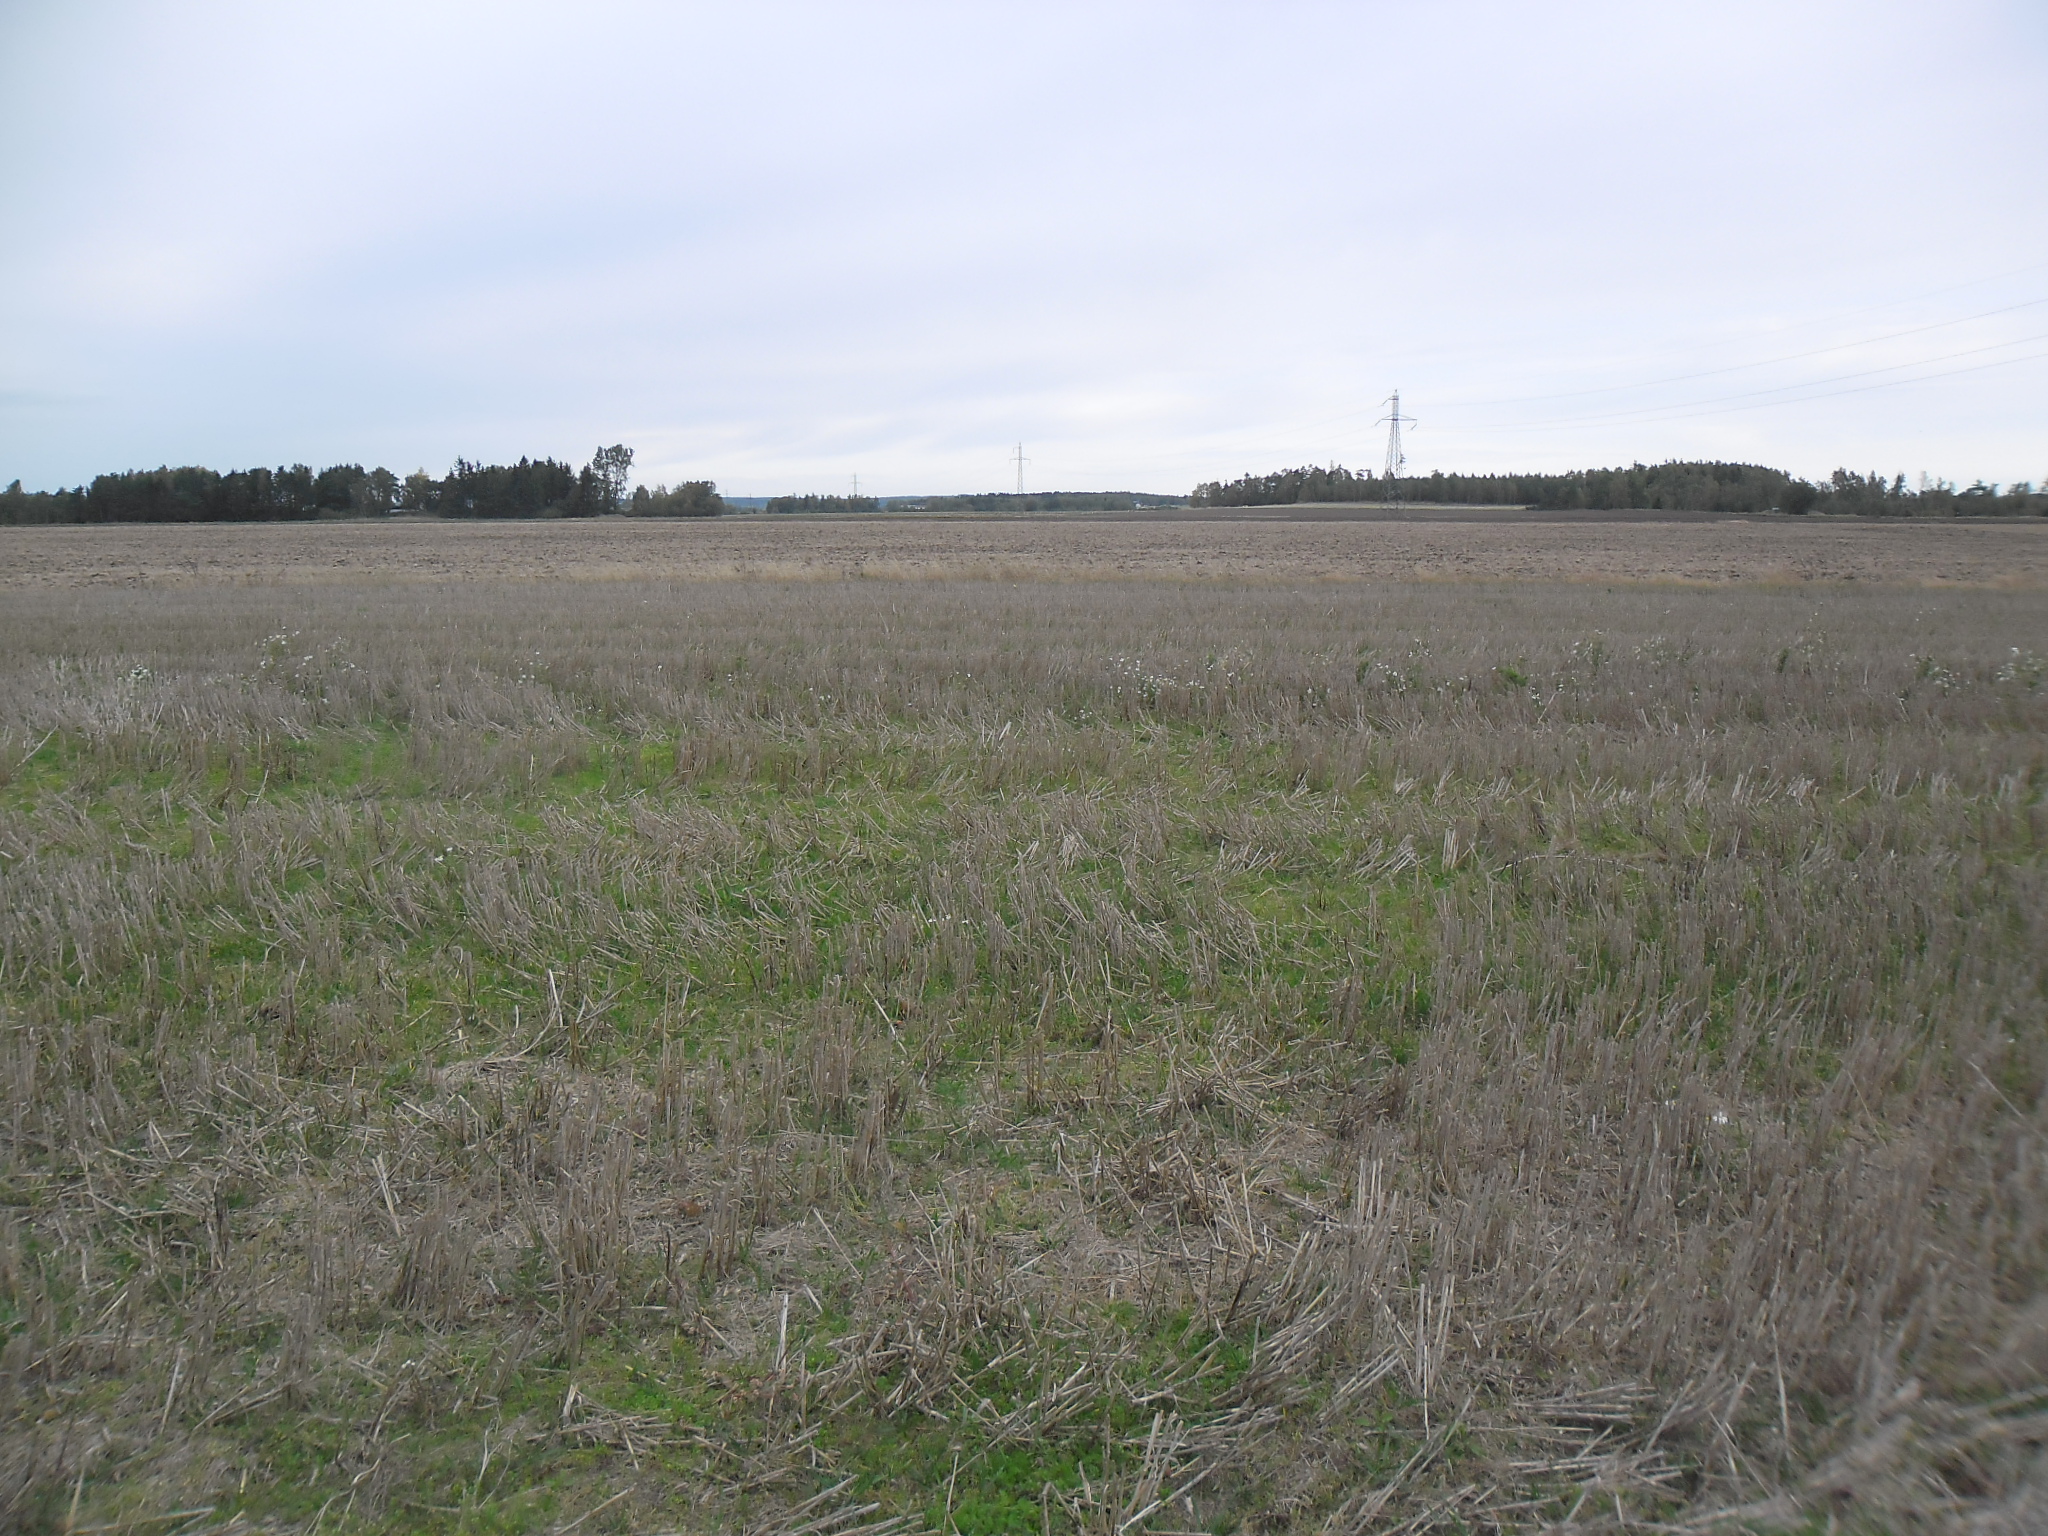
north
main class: Cropland
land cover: Barley
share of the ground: 10 - 25 %
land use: Agriculture (excluding fallow land and kitchen gardens)
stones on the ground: < 10 %
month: October
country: SE
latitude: 56.5281
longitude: 13.1021
